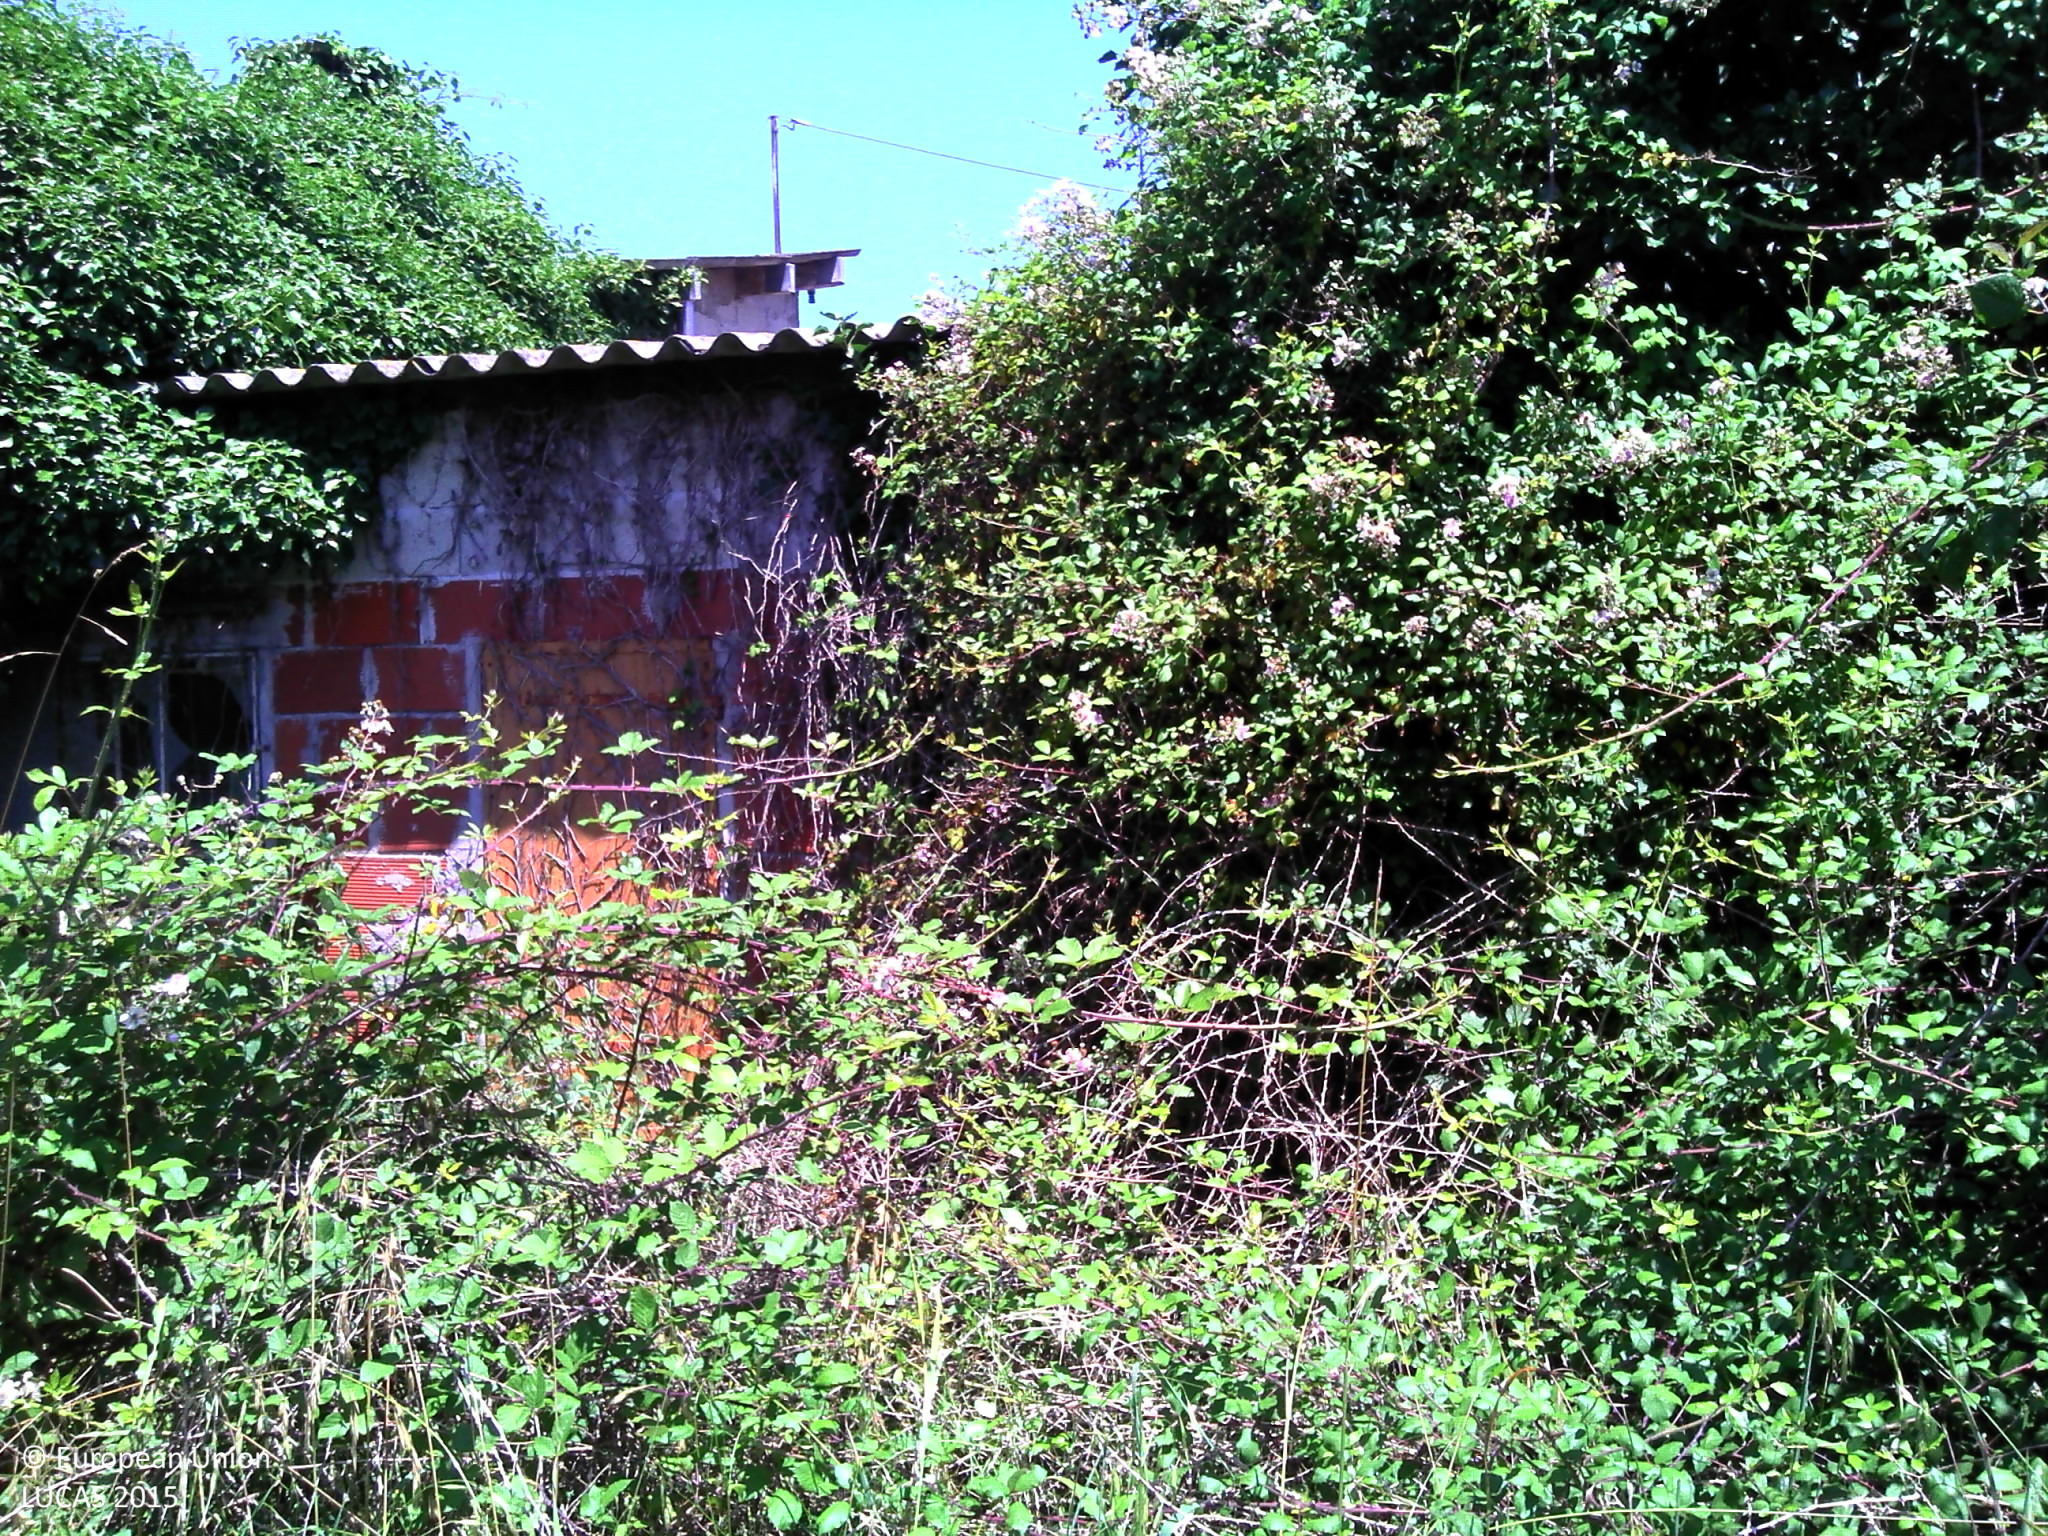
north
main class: Grassland
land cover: Grassland with sparse tree/shrub cover
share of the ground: > 75 %
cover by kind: herbaceous plants 85 %, shrubs 10 %, broadleaved forest trees 5 %
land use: Agriculture (excluding fallow land and kitchen gardens)
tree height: < 5 m
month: June
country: FR
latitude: 43.7280
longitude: -0.4758
